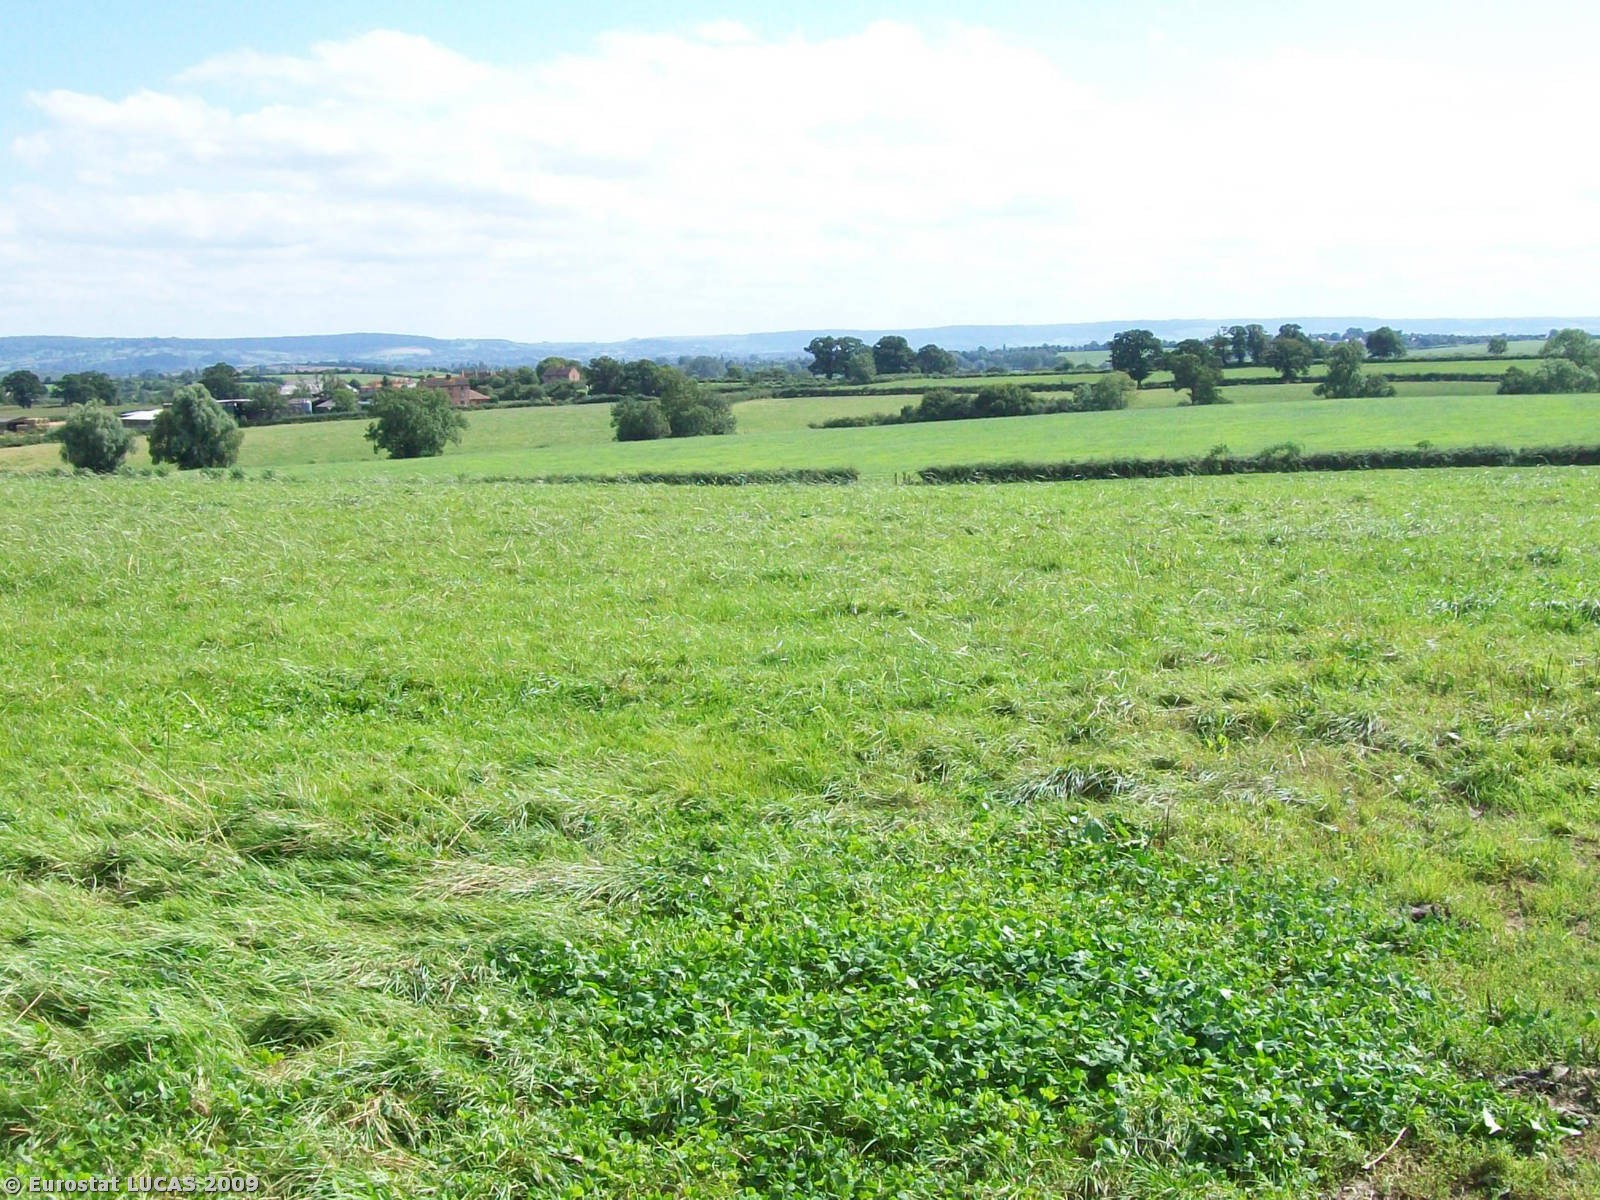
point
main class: Grassland
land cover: Grassland without tree/shrub cover
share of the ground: > 75 %
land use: Agriculture (excluding fallow land and kitchen gardens)
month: August
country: GB
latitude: 51.8526
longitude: -2.3905
